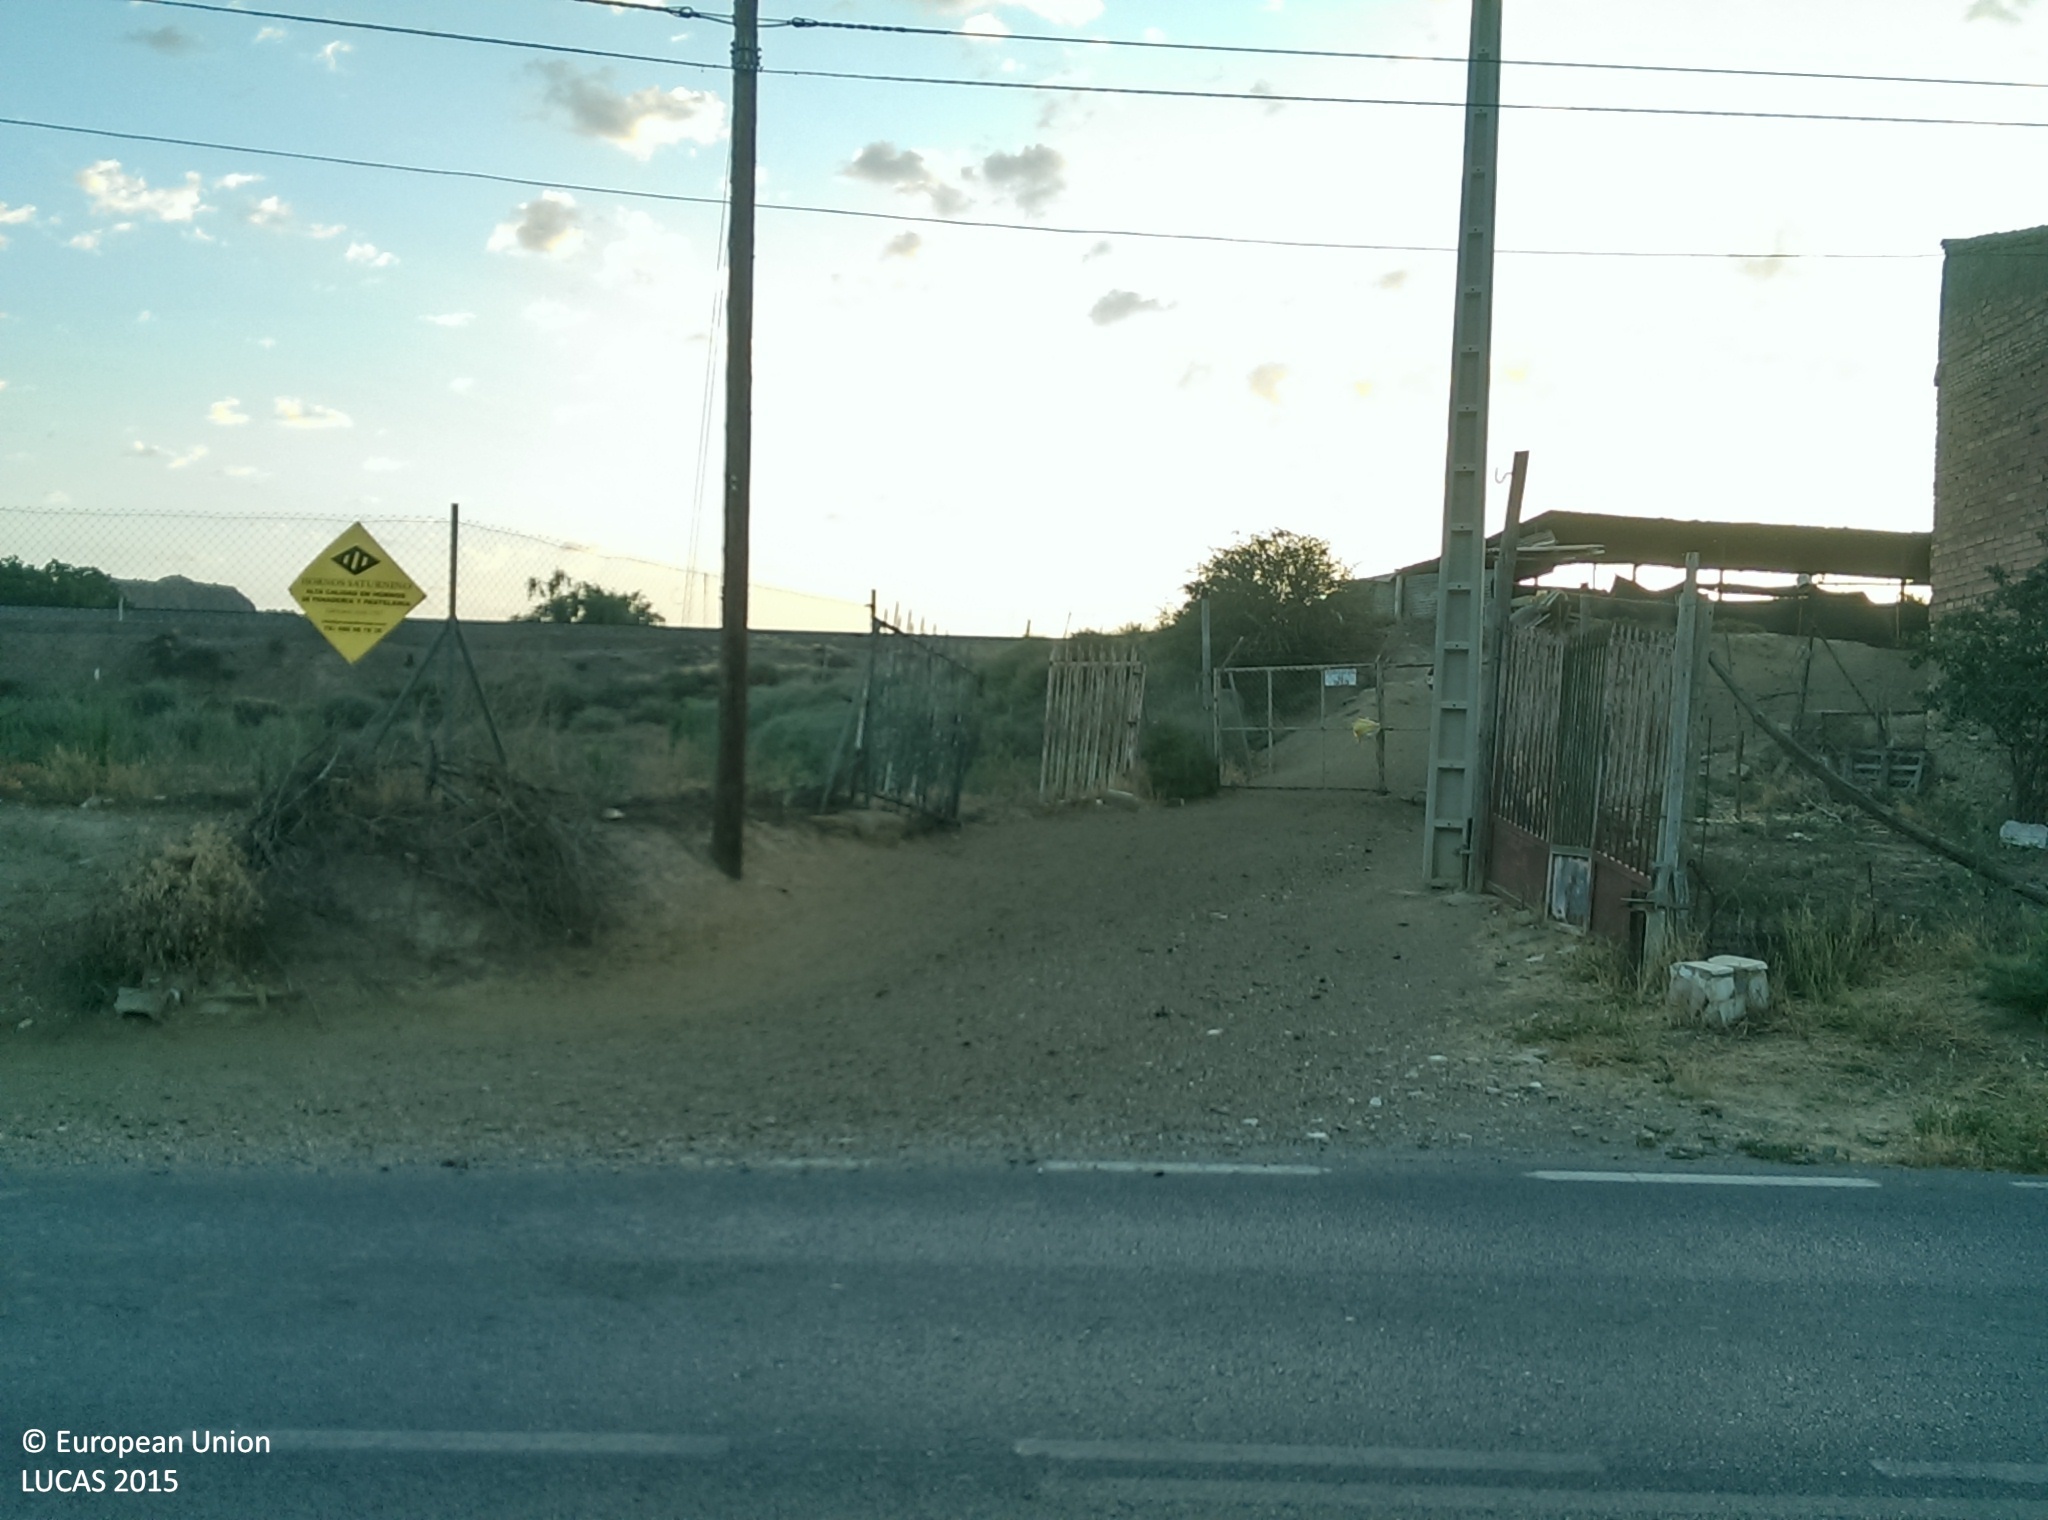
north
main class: Cropland
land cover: Olive groves
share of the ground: 50 - 75 %
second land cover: Other bare soil
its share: > 75 %
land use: Agriculture (excluding fallow land and kitchen gardens)
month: July
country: ES
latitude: 37.3423
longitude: -3.1608
